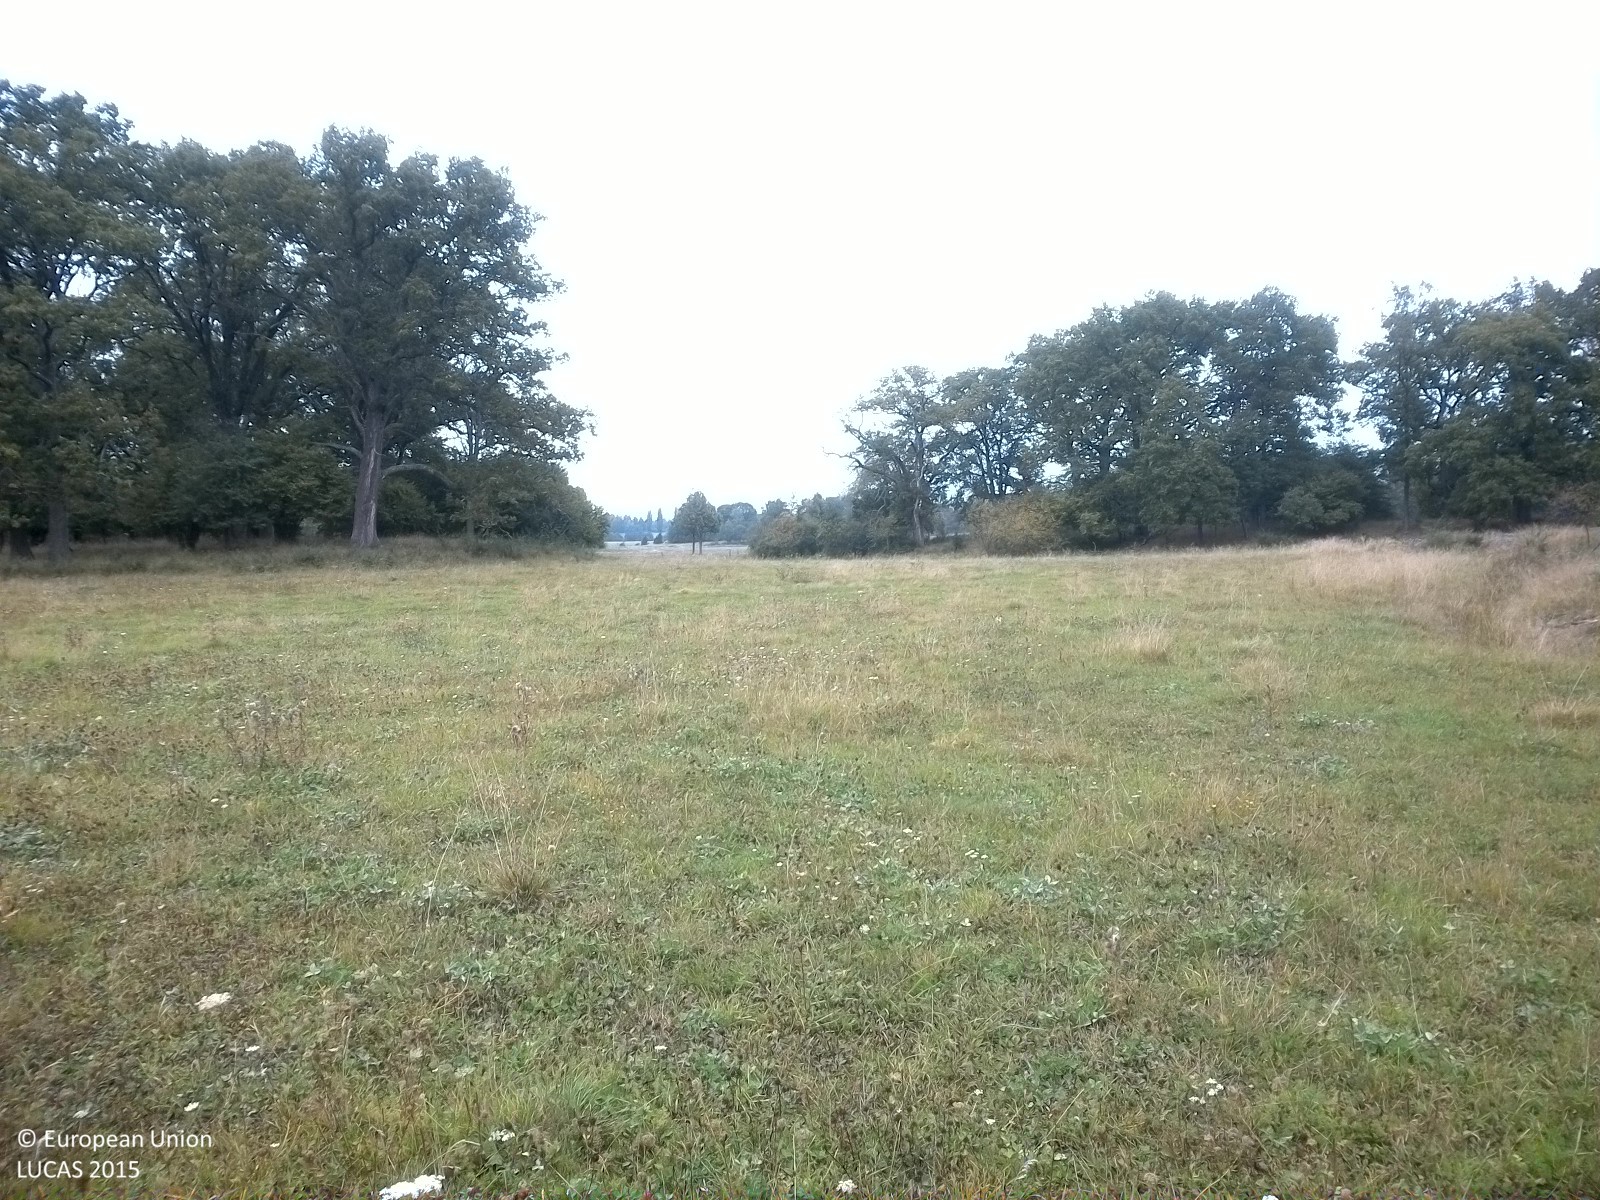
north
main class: Grassland
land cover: Grassland without tree/shrub cover
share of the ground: > 75 %
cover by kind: herbaceous plants 100 %
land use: Agriculture (excluding fallow land and kitchen gardens)
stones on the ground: < 10 %
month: September
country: SE
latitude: 58.6111
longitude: 16.3472
